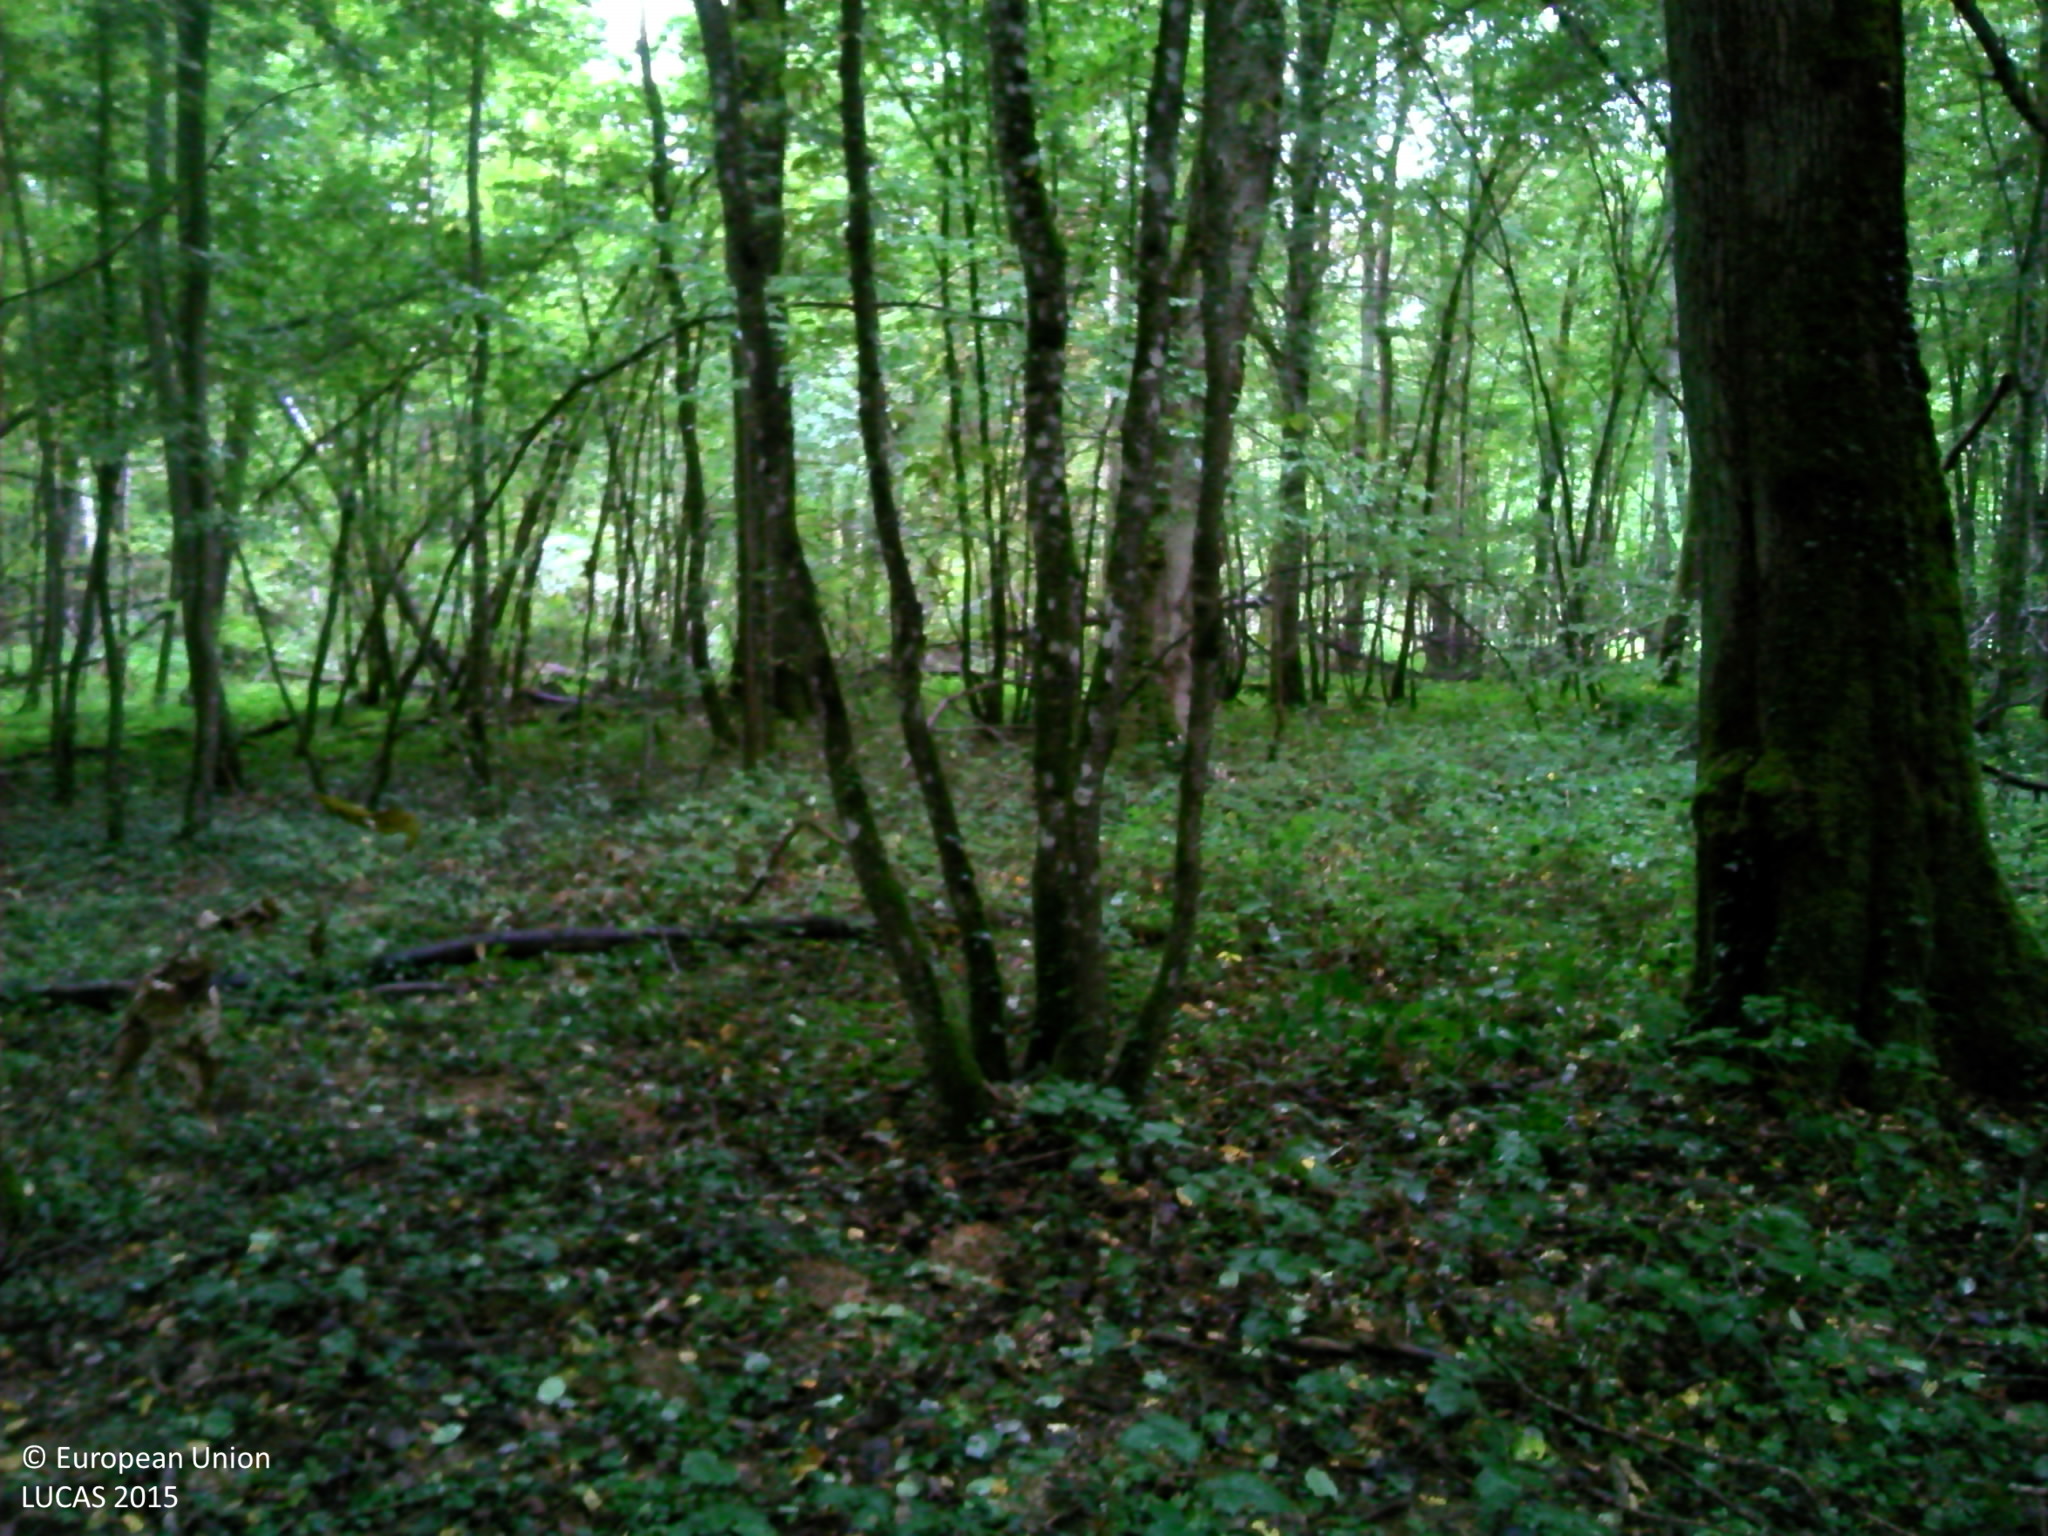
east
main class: Woodland
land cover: Broadleaved woodland
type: acidophilous oak and oak-birch forest
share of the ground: > 75 %
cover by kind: broadleaved forest trees 95 %, herbaceous plants 5 %
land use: Forestry
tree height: > 5 m
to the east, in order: Broadleaved woodland; Ditches and canals; Broadleaved woodland
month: September
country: FR
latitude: 47.0671
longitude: 5.0632
